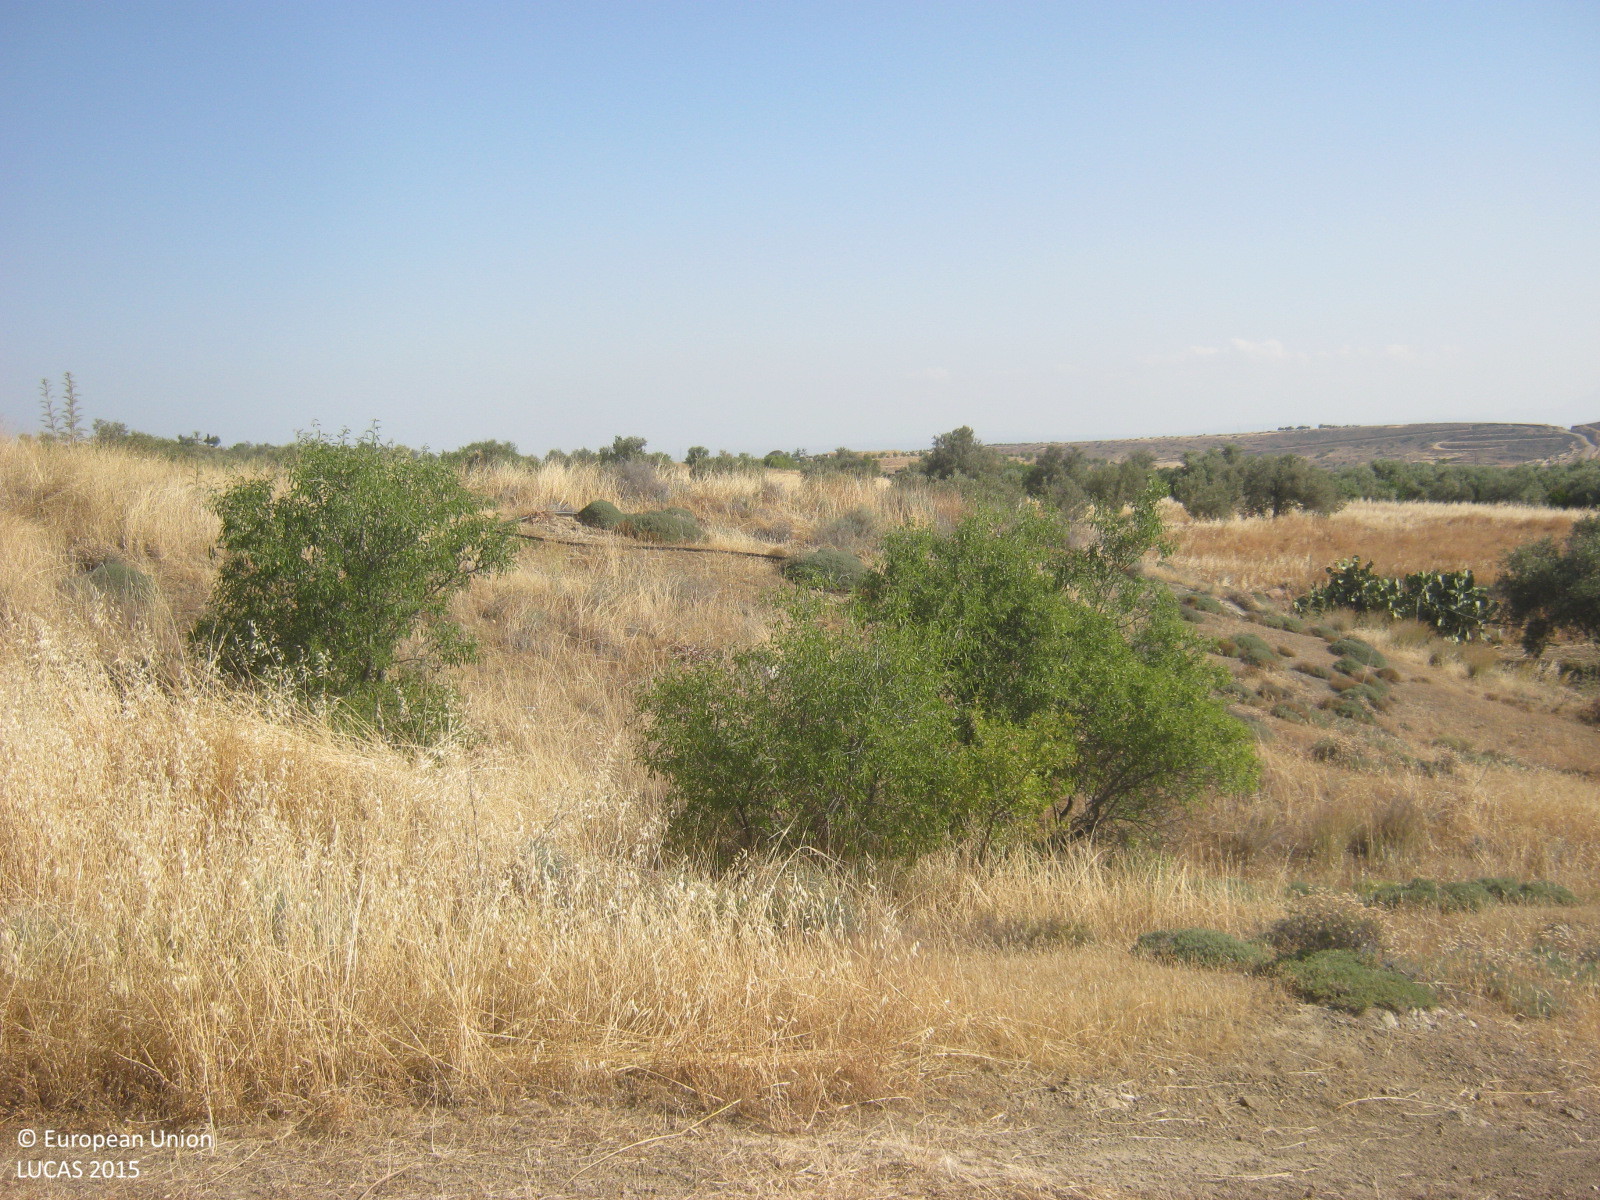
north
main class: Cropland
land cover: Nuts trees
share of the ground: 10 - 25 %
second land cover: Spontaneously vegetated surfaces
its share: > 75 %
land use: Agriculture (excluding fallow land and kitchen gardens)
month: May
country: CY
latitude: 35.0757
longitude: 32.9984
